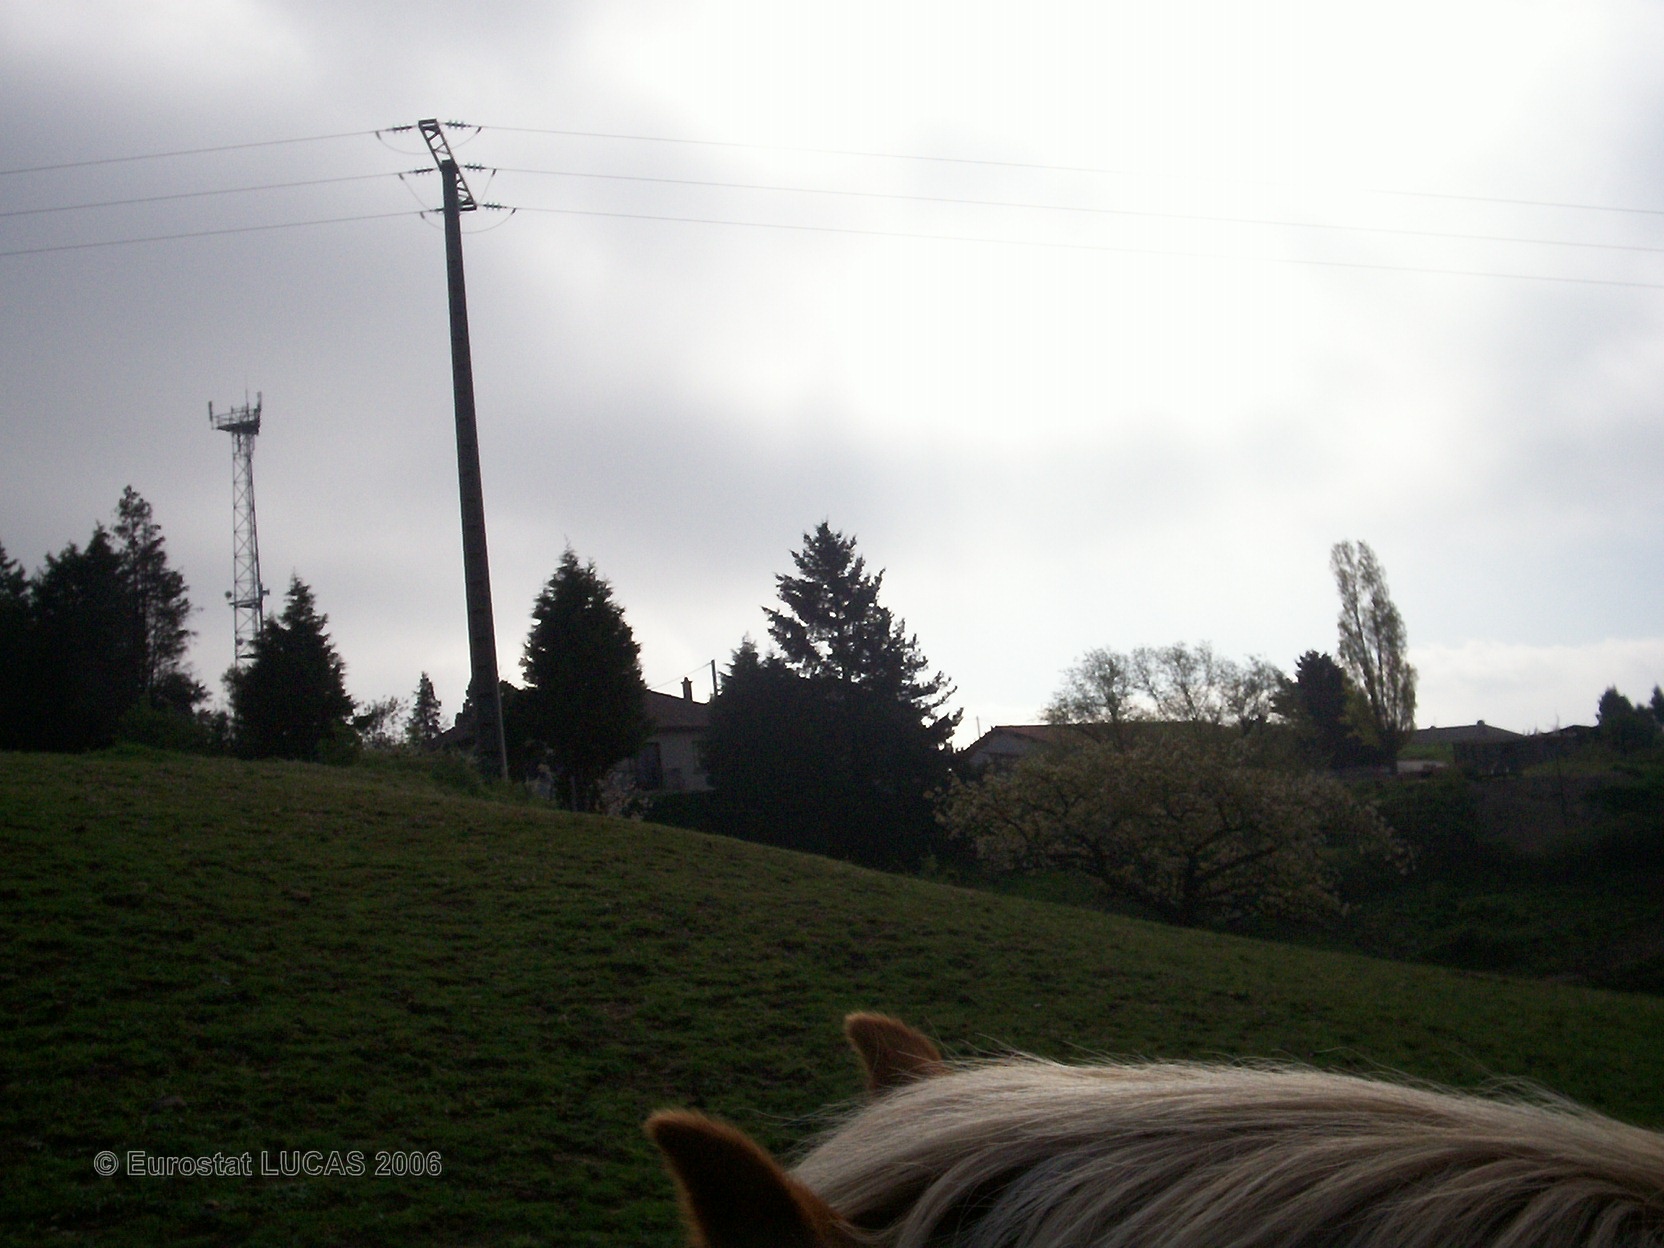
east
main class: Grassland
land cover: Grassland with sparse tree/shrub cover
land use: Agriculture (excluding fallow land and kitchen gardens)
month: April
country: FR
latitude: 45.4832
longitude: 4.7715
